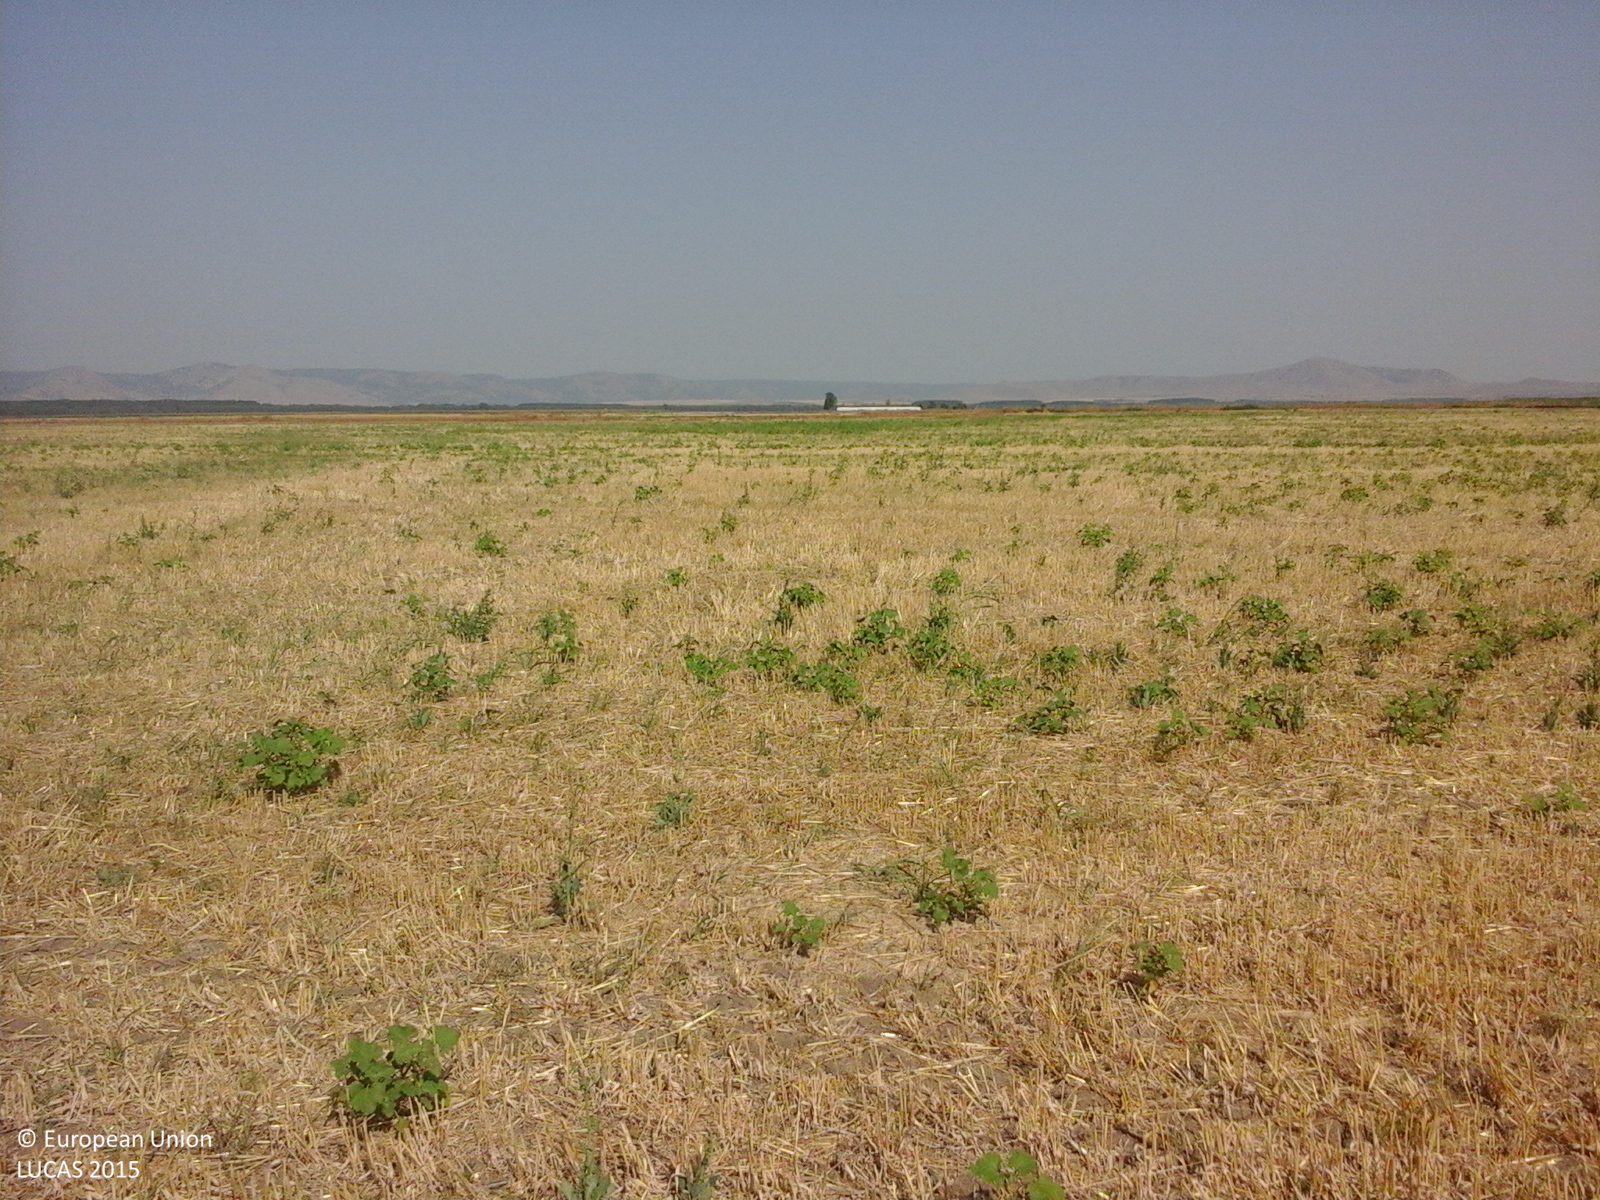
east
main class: Cropland
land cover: Rye
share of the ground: > 75 %
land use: Agriculture (excluding fallow land and kitchen gardens)
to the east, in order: Rye
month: August
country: RO
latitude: 45.1604
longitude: 28.0927
